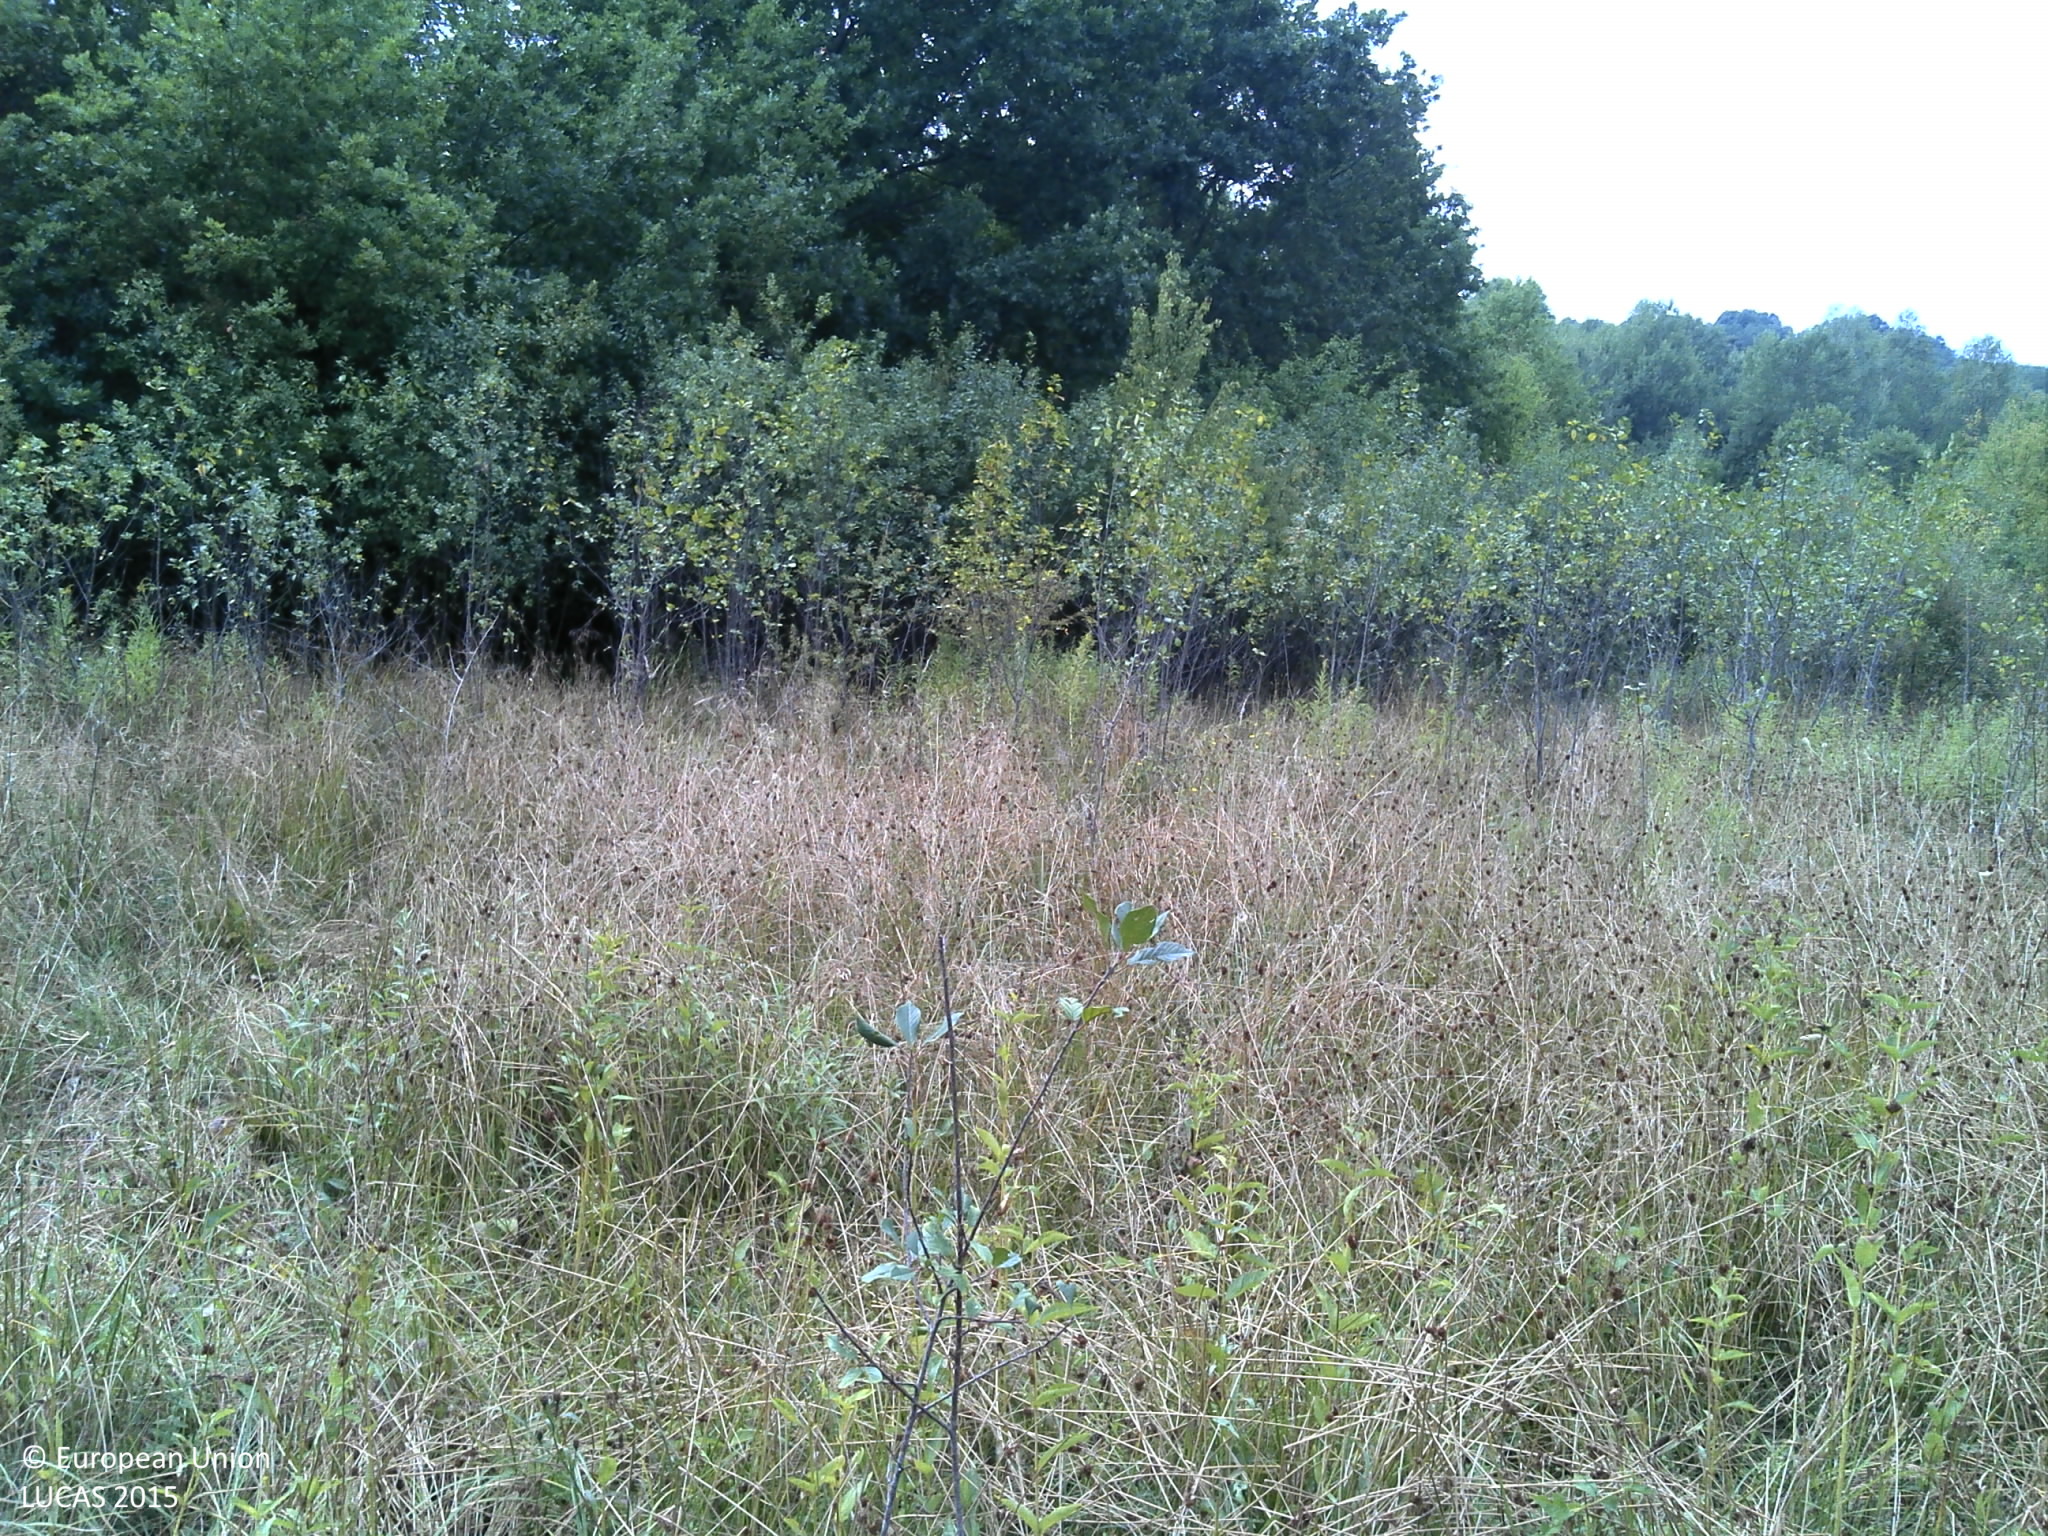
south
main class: Grassland
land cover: Spontaneously vegetated surfaces
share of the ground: > 75 %
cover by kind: herbaceous plants 100 %
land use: Fallow land
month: August
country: HR
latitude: 45.4066
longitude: 15.9890
